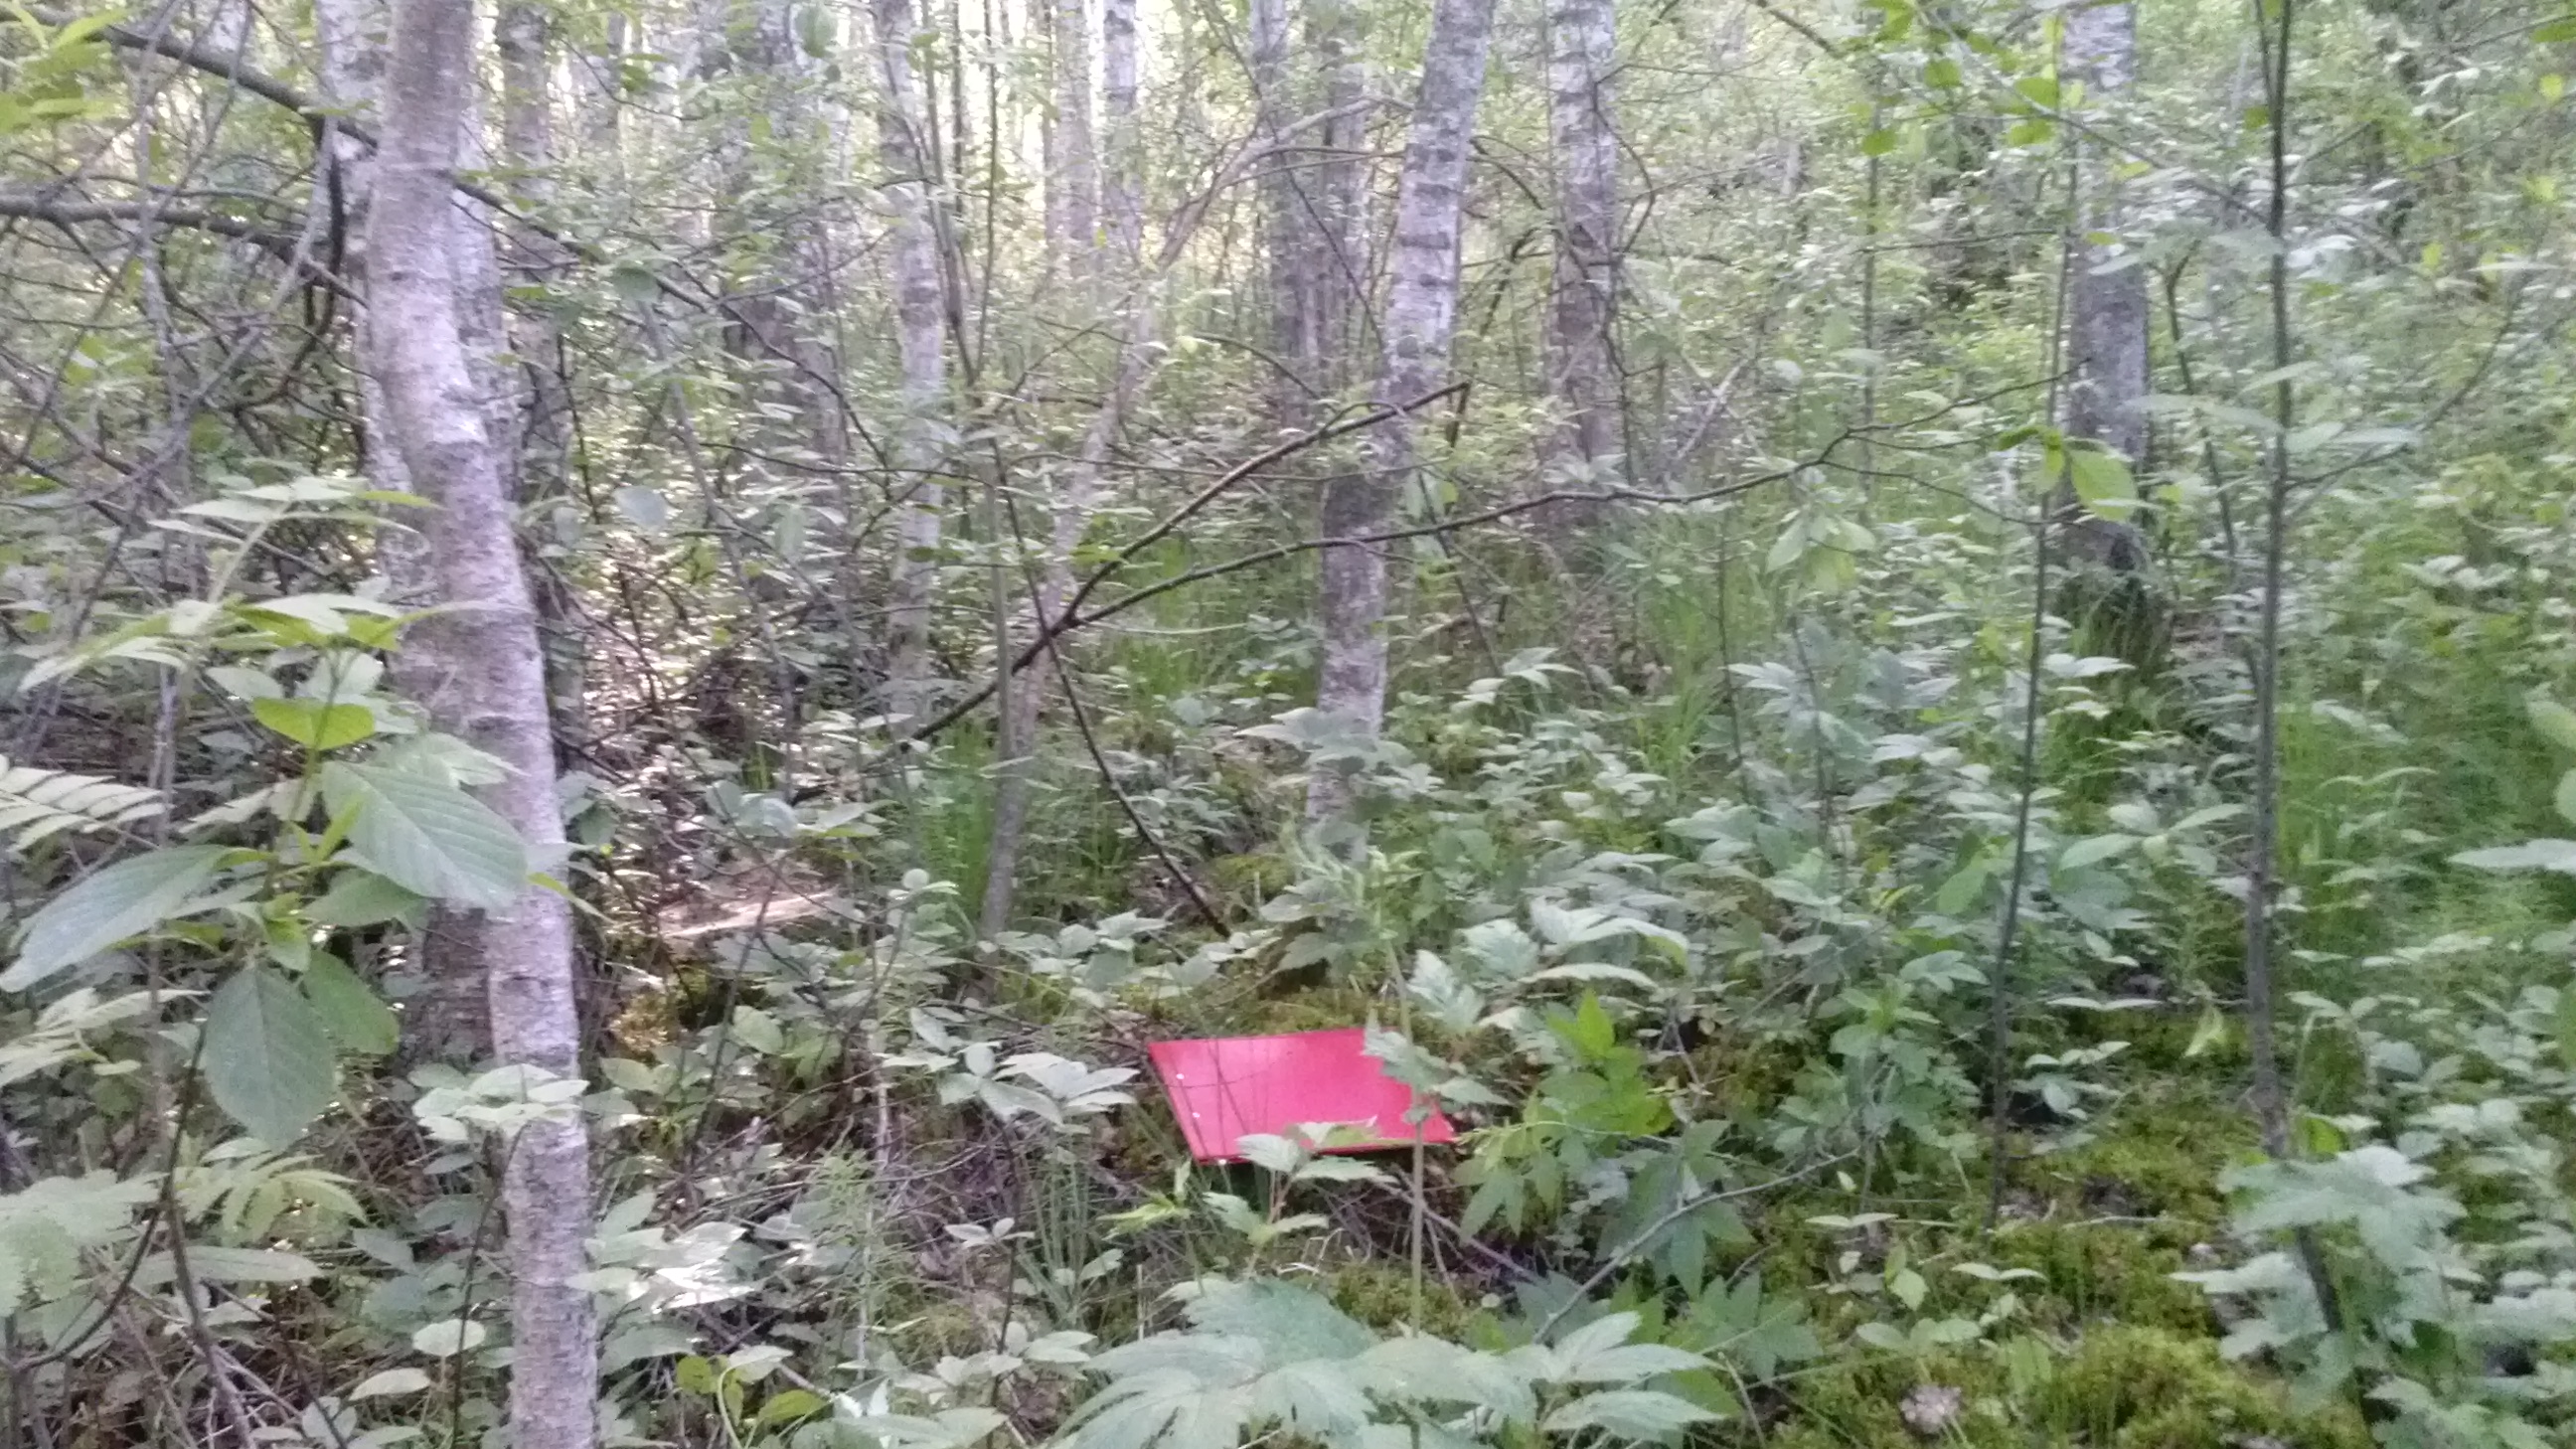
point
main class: Woodland
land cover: Broadleaved woodland
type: non-riverine alder, birch or aspen forest
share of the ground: > 75 %
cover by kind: broadleaved forest trees 95 %, herbaceous plants 5 %
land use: Forestry
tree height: > 5 m
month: June
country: LV
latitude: 56.4088
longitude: 27.9073
